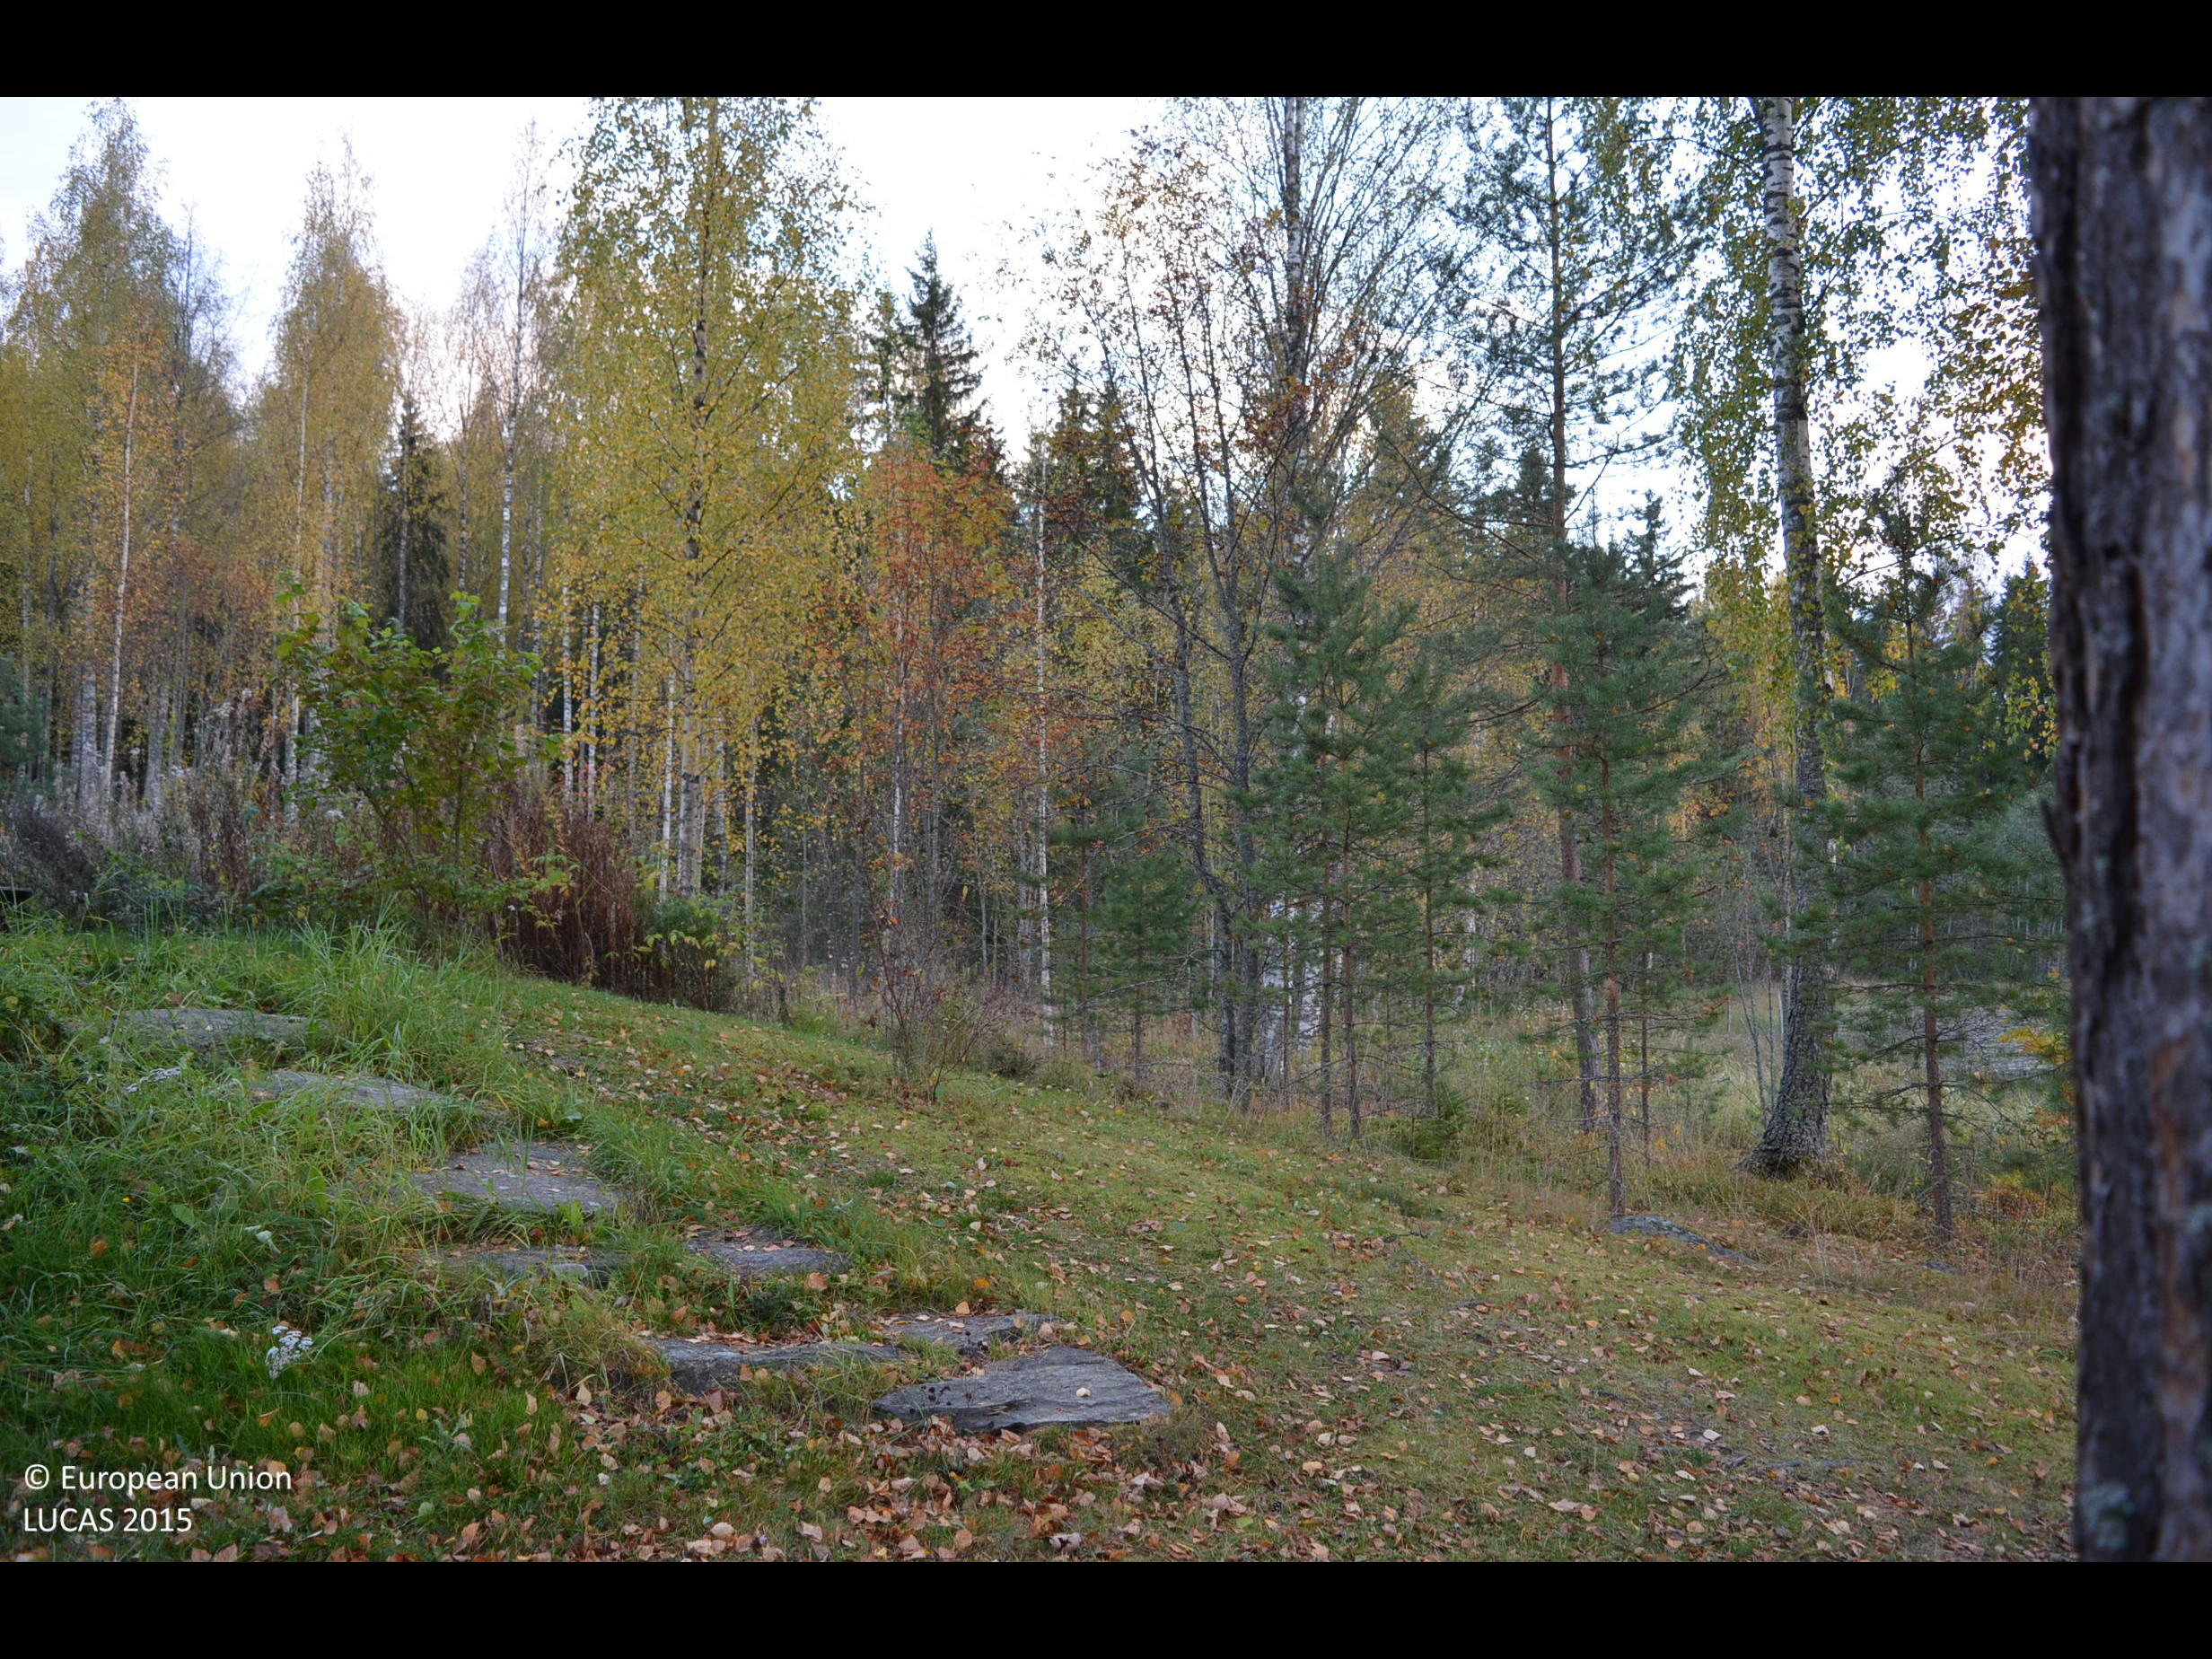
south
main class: Woodland
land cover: Other mixed woodland
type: boreal forest
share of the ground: 50 - 75 %
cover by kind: herbaceous plants 40 %, coniferous forest trees 25 %, broadleaved forest trees 25 %, shrubs 10 %
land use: Residential
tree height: > 5 m
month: October
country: FI
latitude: 61.6351
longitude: 23.8781
